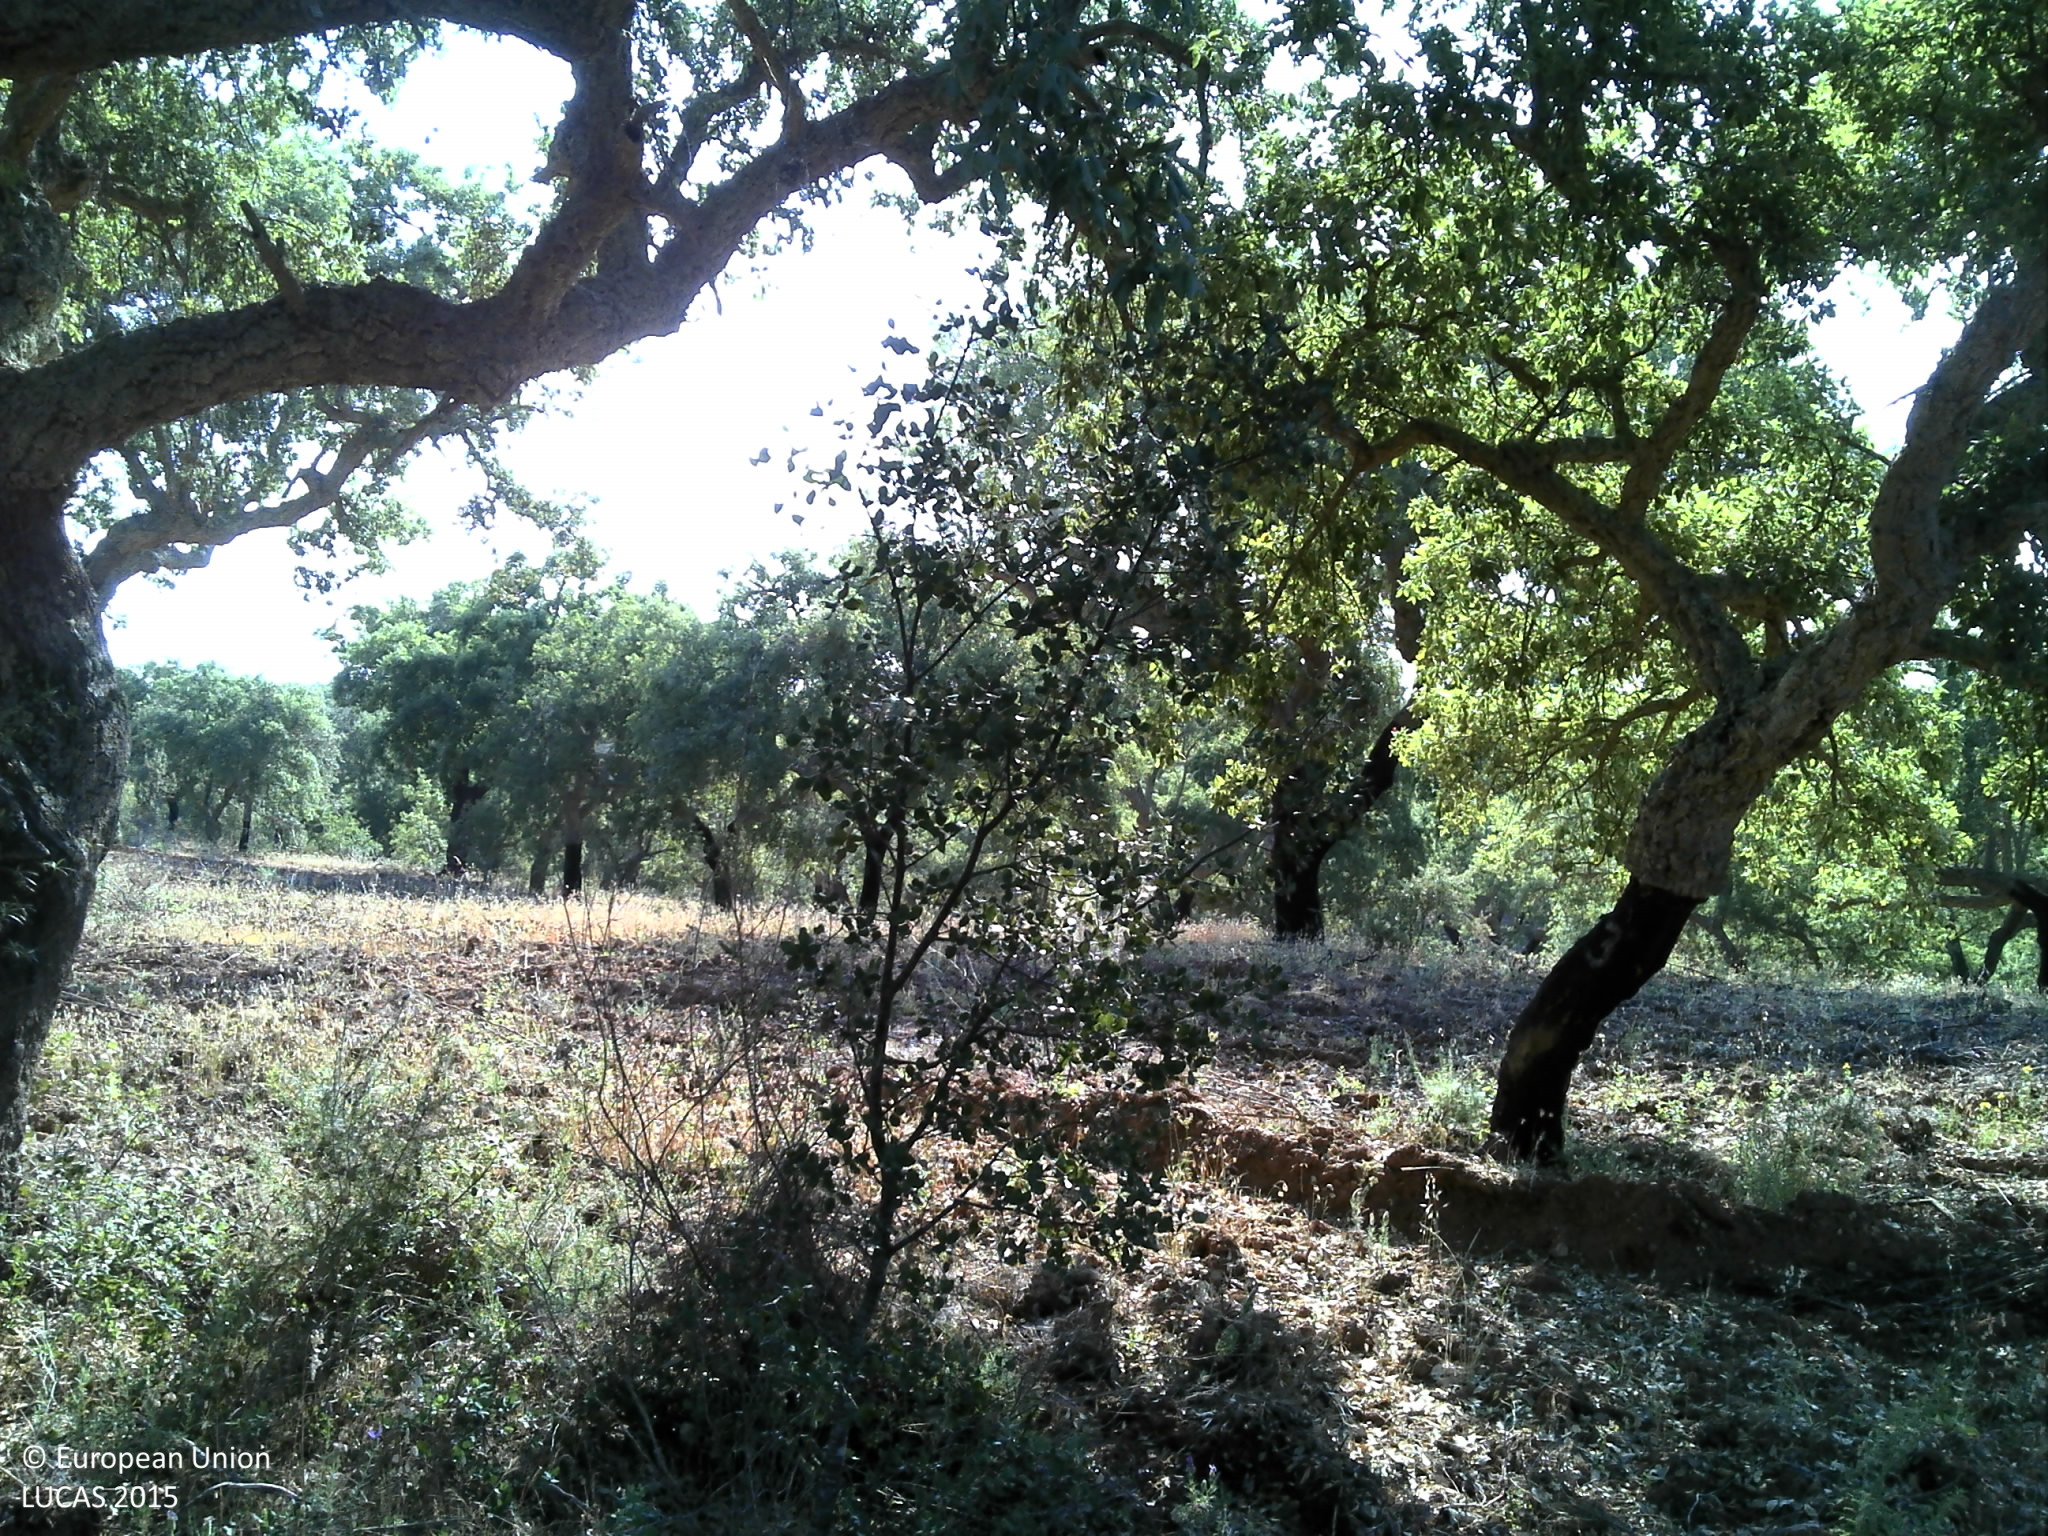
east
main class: Woodland
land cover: Broadleaved woodland
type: broadleaved evergreen forest
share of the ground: 50 - 75 %
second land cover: Spontaneously vegetated surfaces
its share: 10 - 25 %
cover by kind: broadleaved forest trees 60 %, unconsolidated bare surface 25 %, herbaceous plants 15 %
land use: Forestry
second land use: Agriculture (excluding fallow land and kitchen gardens)
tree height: > 5 m
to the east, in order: Broadleaved woodland; Spontaneously vegetated surfaces; Broadleaved woodland
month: May
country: PT
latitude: 38.8863
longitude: -7.7845
